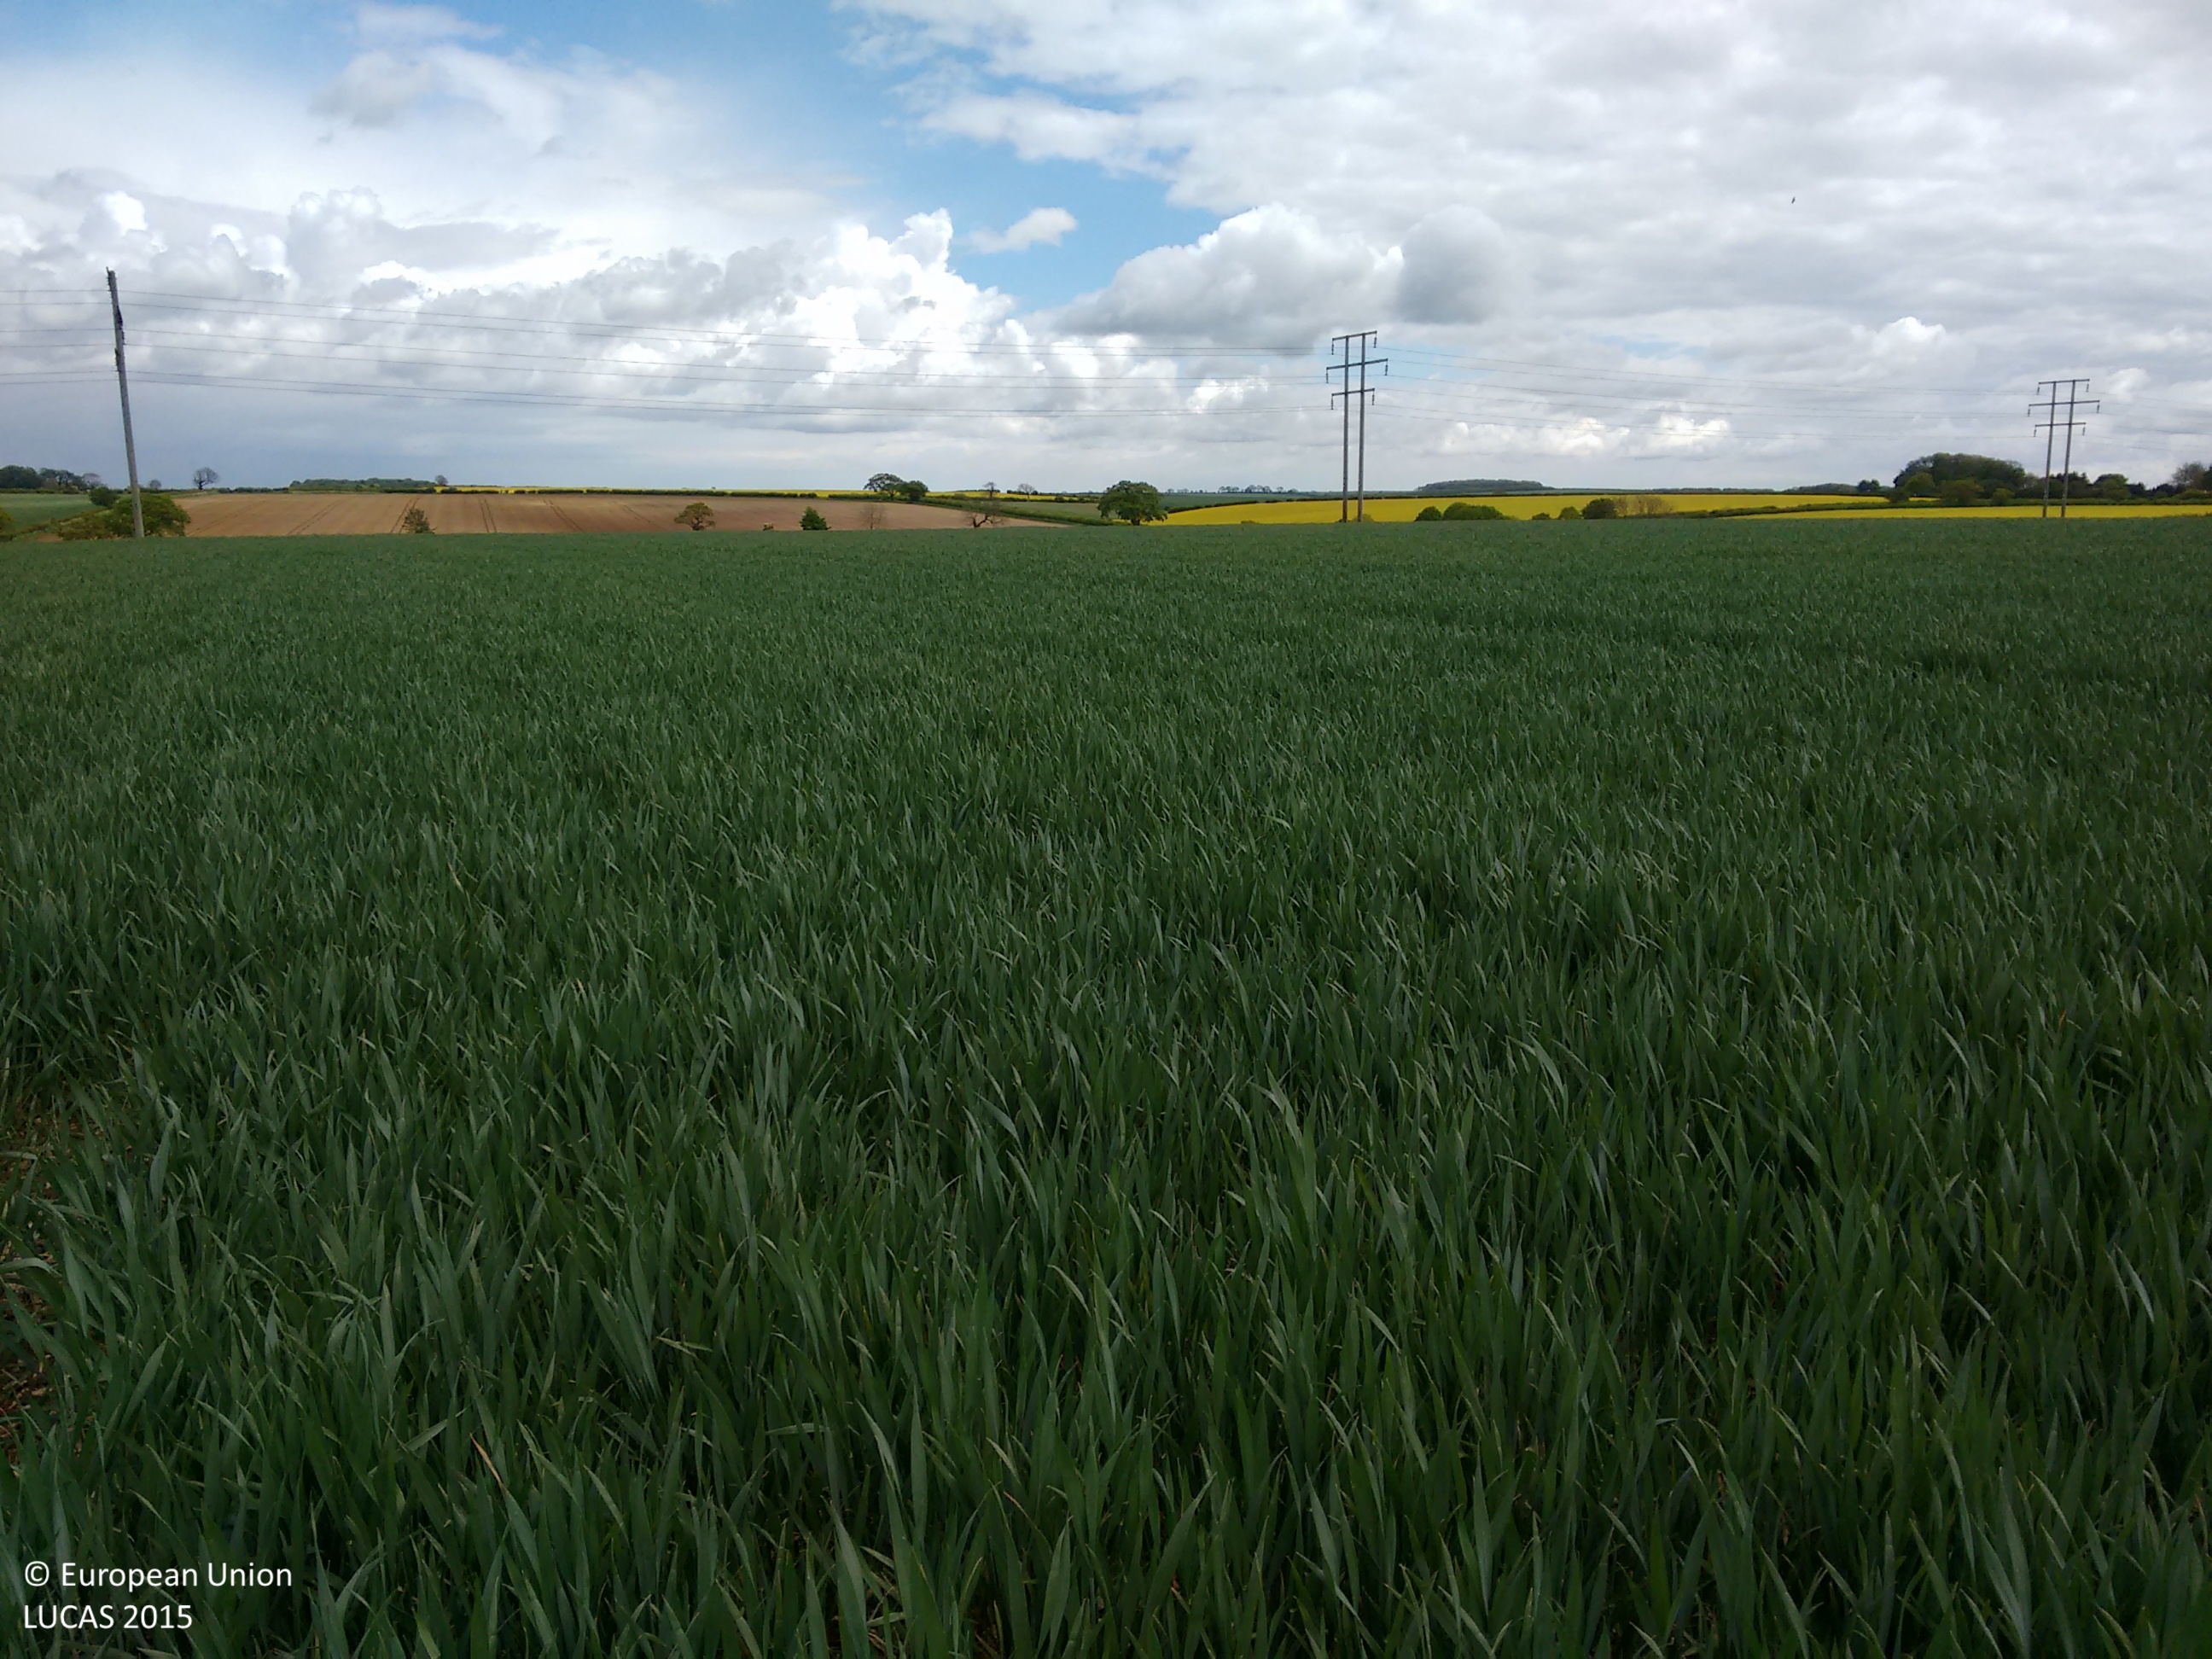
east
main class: Cropland
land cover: Common wheat
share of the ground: > 75 %
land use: Agriculture (excluding fallow land and kitchen gardens)
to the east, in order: Common wheat; Electric lines; Common wheat
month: May
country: GB
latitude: 53.4620
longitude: -0.1703
